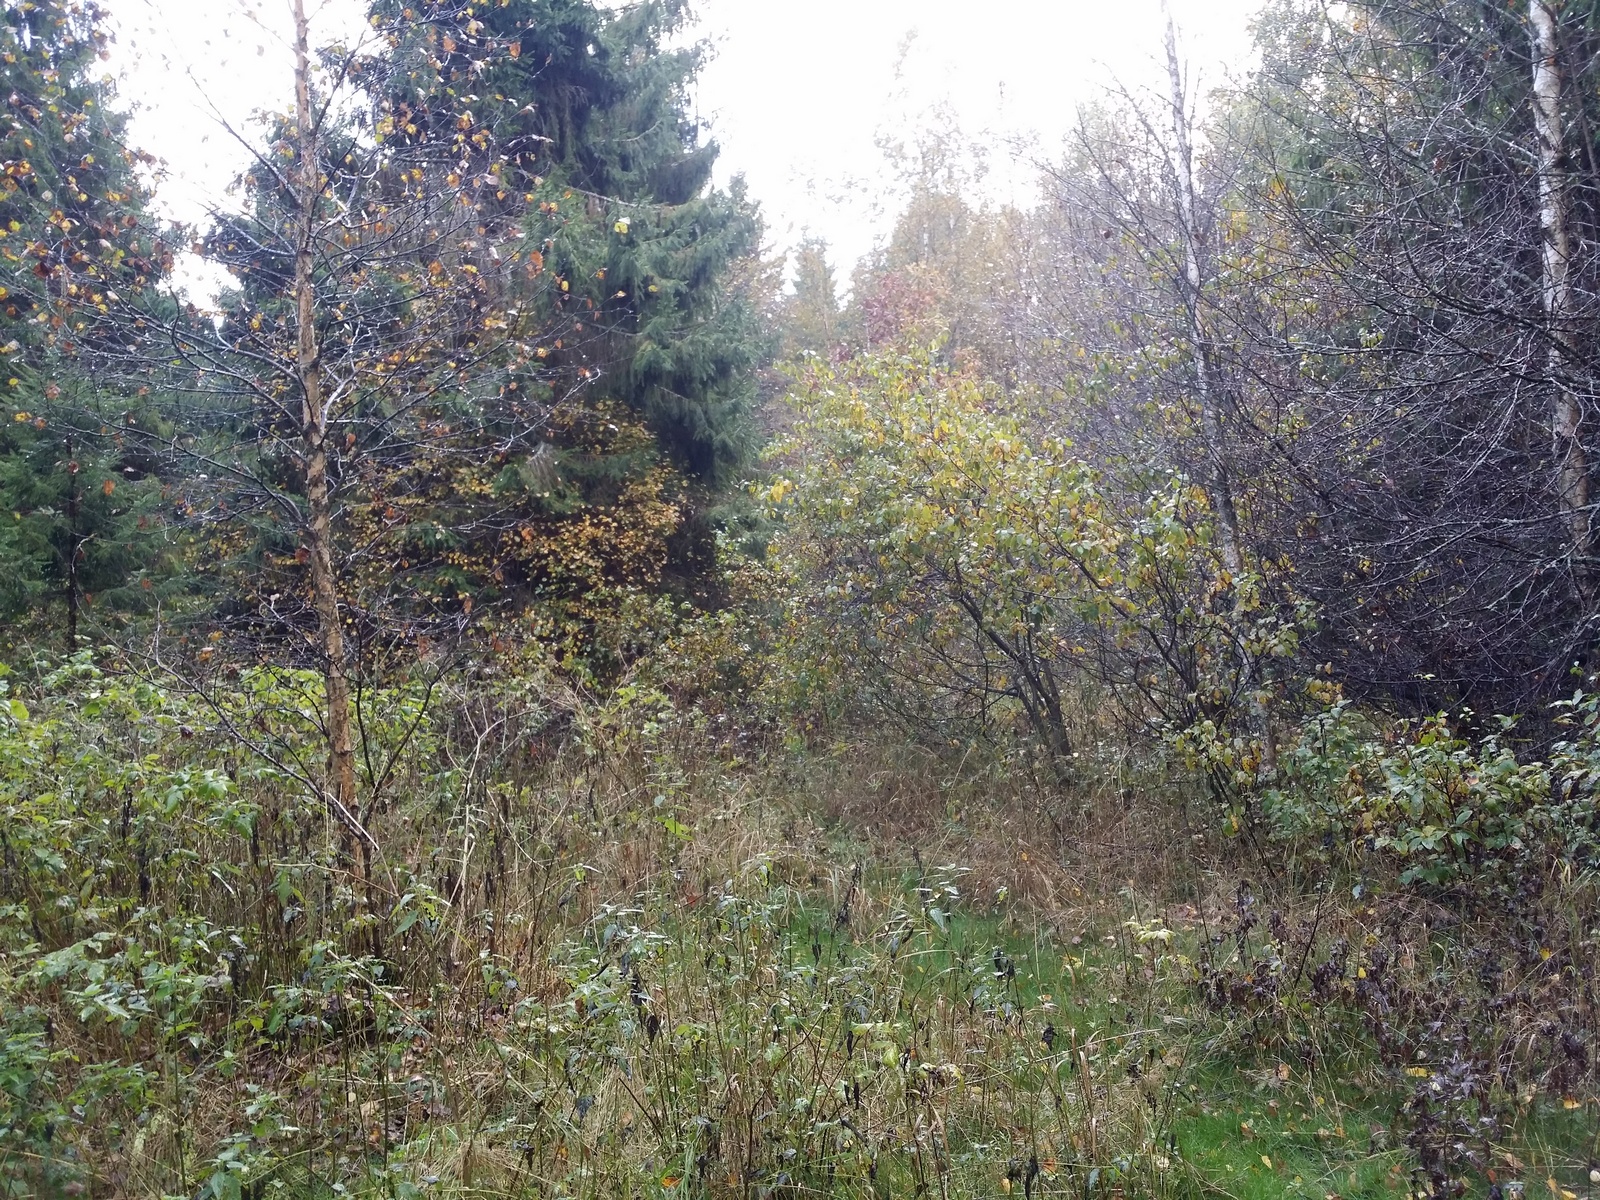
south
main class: Woodland
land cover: Spruce dominated mixed woodland
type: hemiboreal forest and nemoral coniferous forest and mixed broadleaved-coniferous forest
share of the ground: 50 - 75 %
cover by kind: coniferous forest trees 40 %, broadleaved forest trees 25 %, shrubs 15 %, herbaceous plants 10 %, lichens and mosses 10 %
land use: Forestry
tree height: > 5 m
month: September
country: LV
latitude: 57.4944
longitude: 27.4061
